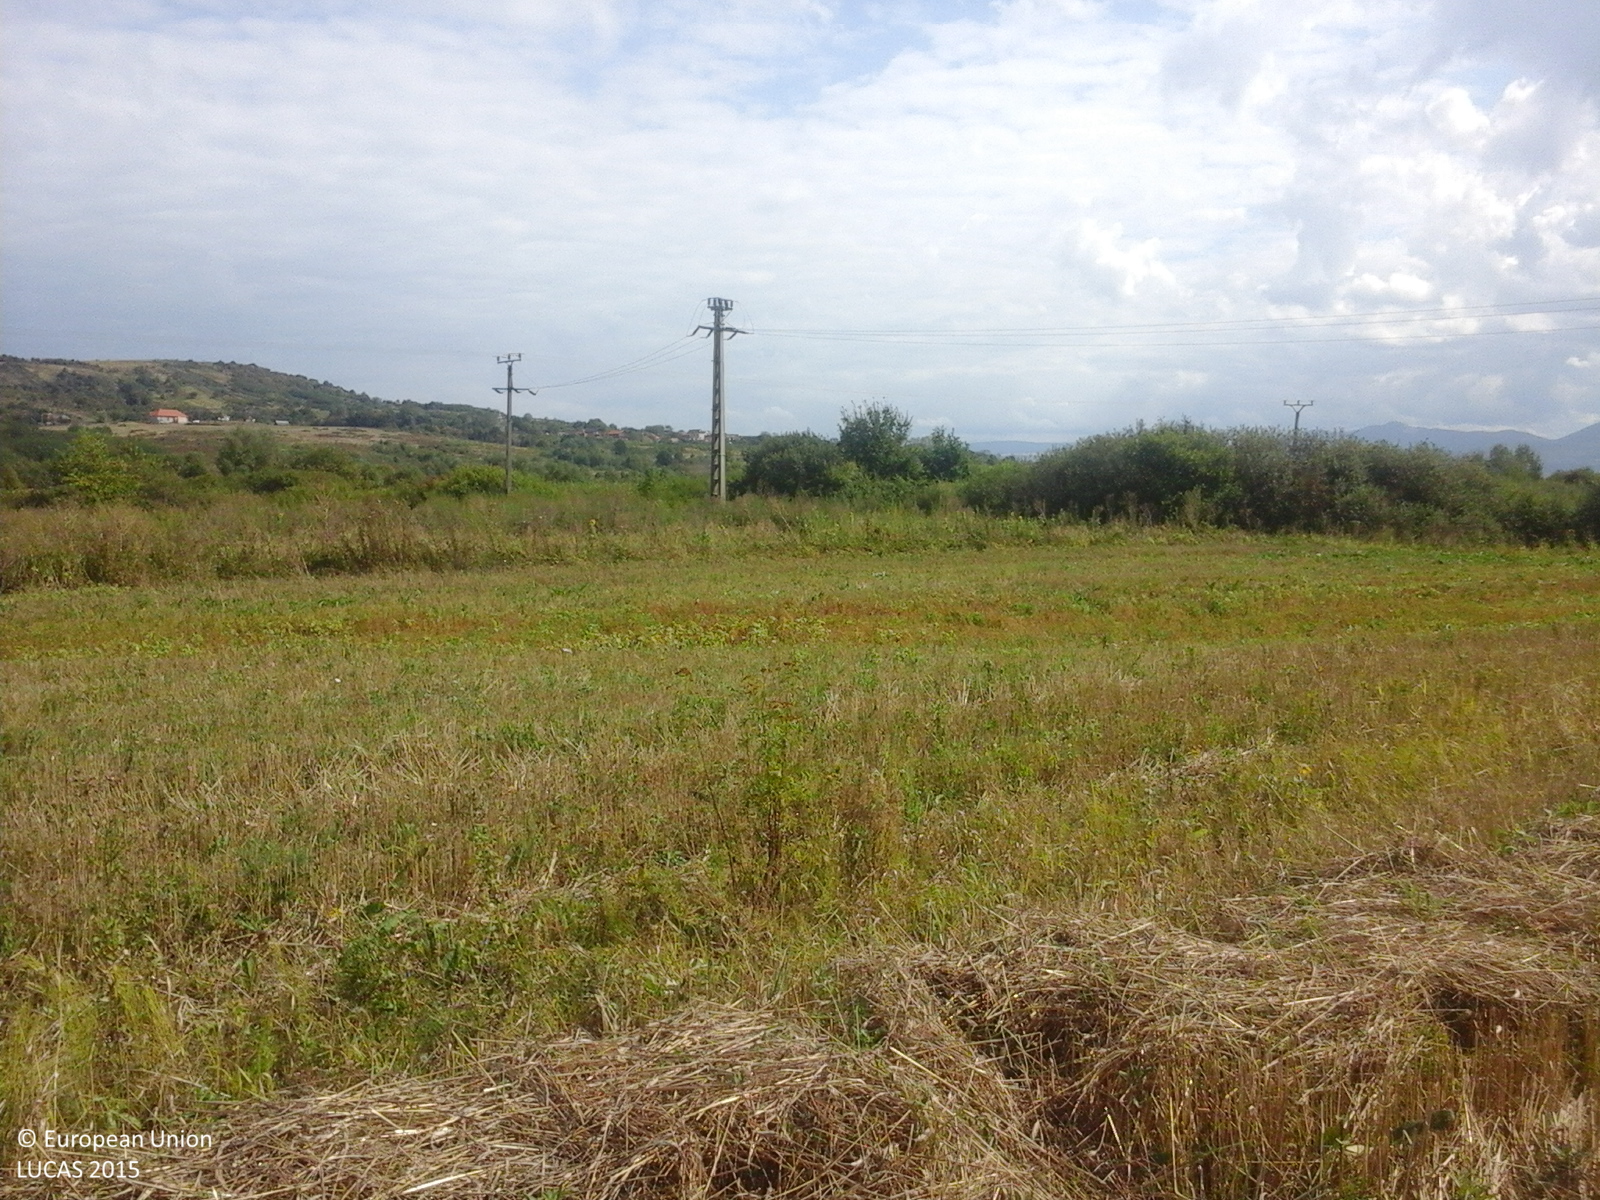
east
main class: Cropland
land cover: Common wheat
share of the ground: > 75 %
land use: Agriculture (excluding fallow land and kitchen gardens)
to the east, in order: Common wheat; Spontaneously vegetated surfaces; Electric lines; Abandoned hedges; Ditches and canals; Lucerne; Shrubland with sparse tree cover; Ditches and canals; Shrubland with sparse tree cover; Spontaneously vegetated surfaces; Oats; Grassland without tree/shrub cover; Tracks; Grassland without tree/shrub cover; Sunflower
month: September
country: RO
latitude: 47.8554
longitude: 23.2632
